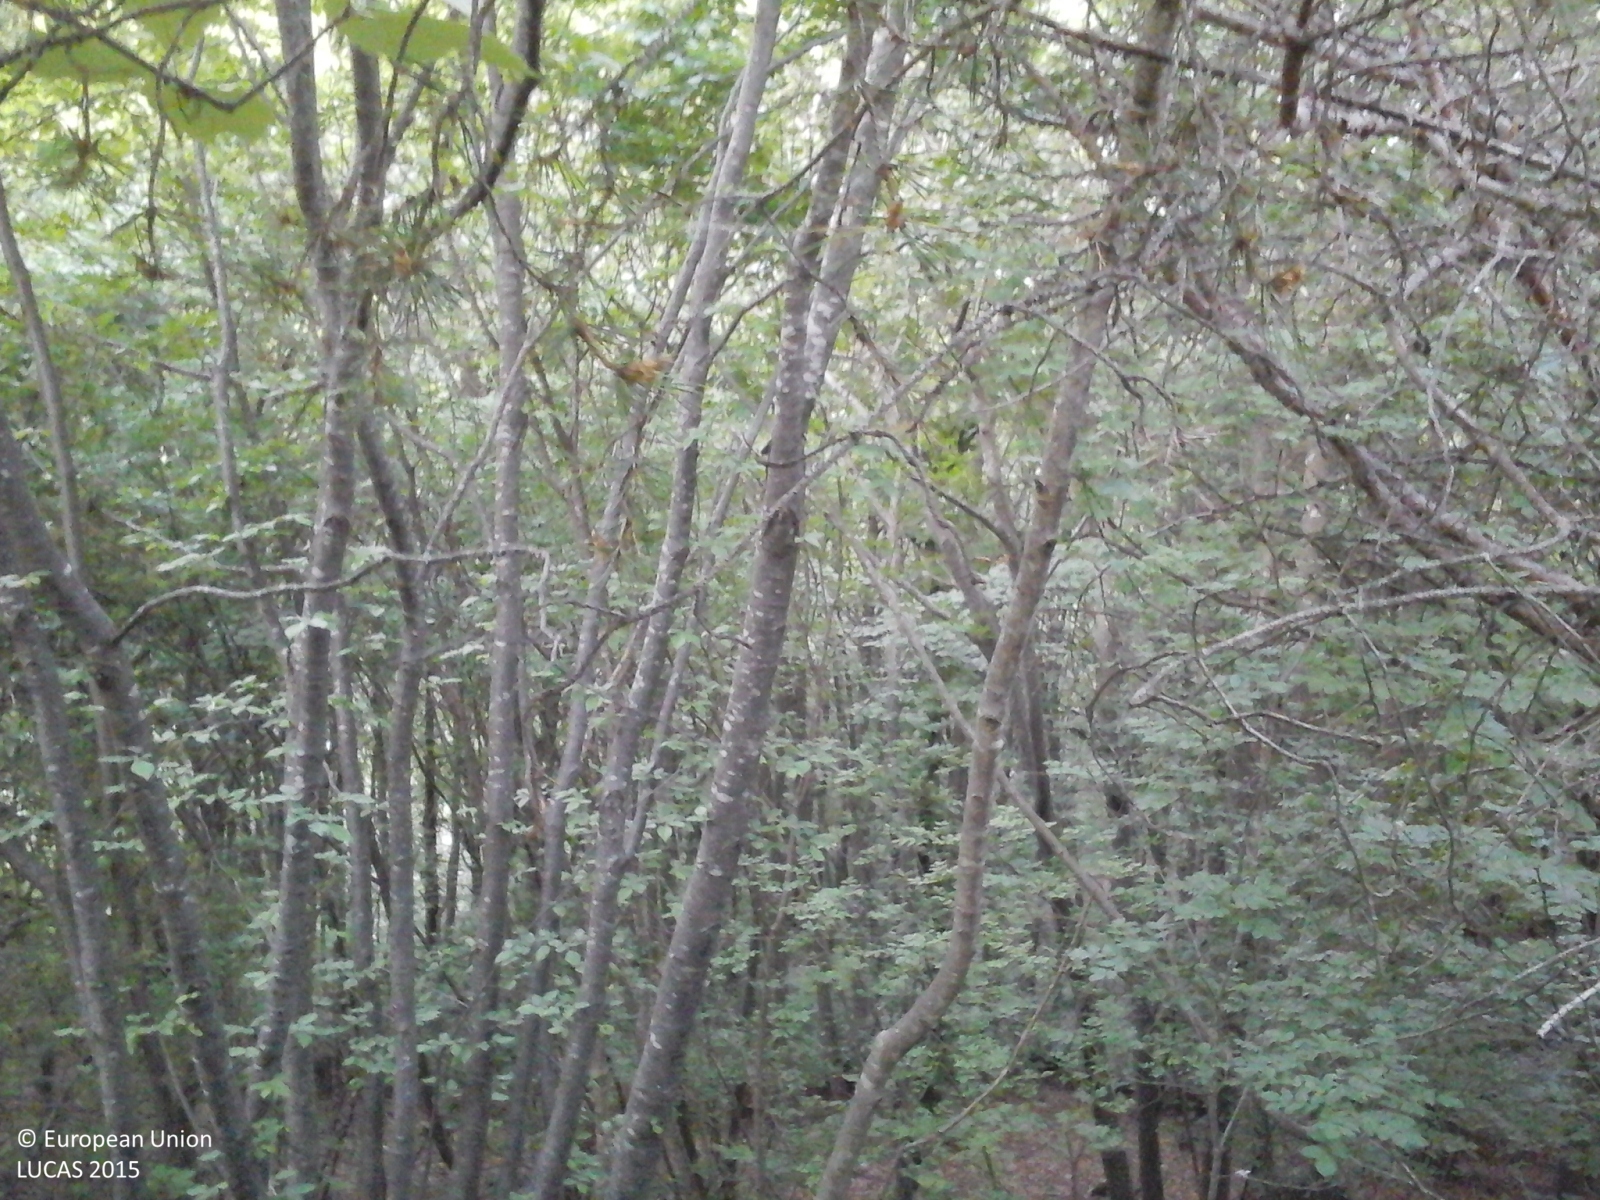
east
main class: Woodland
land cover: Broadleaved woodland
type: mountainous beech forest
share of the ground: > 75 %
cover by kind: broadleaved forest trees 100 %
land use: Forestry
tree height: > 5 m
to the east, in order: Broadleaved woodland; Tracks; Other mixed woodland; Broadleaved woodland
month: June
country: IT
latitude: 45.9865
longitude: 10.9668
